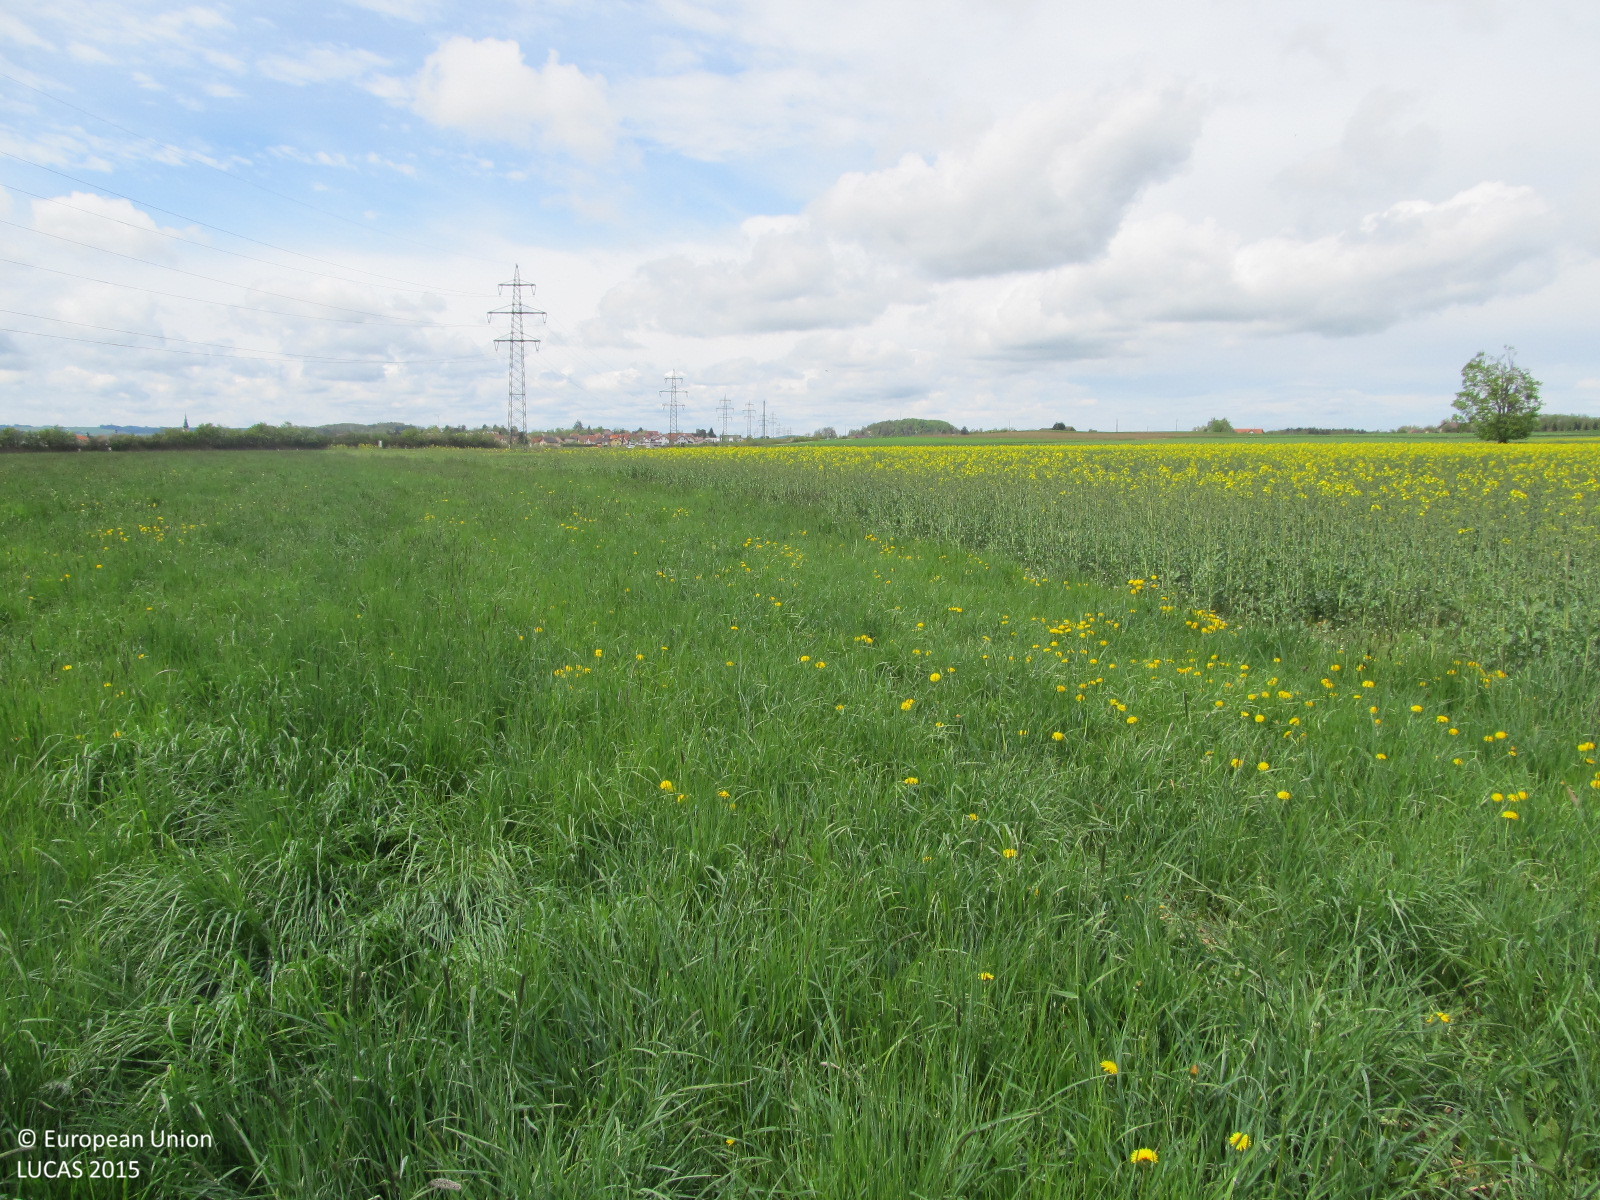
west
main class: Cropland
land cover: Temporary grasslands
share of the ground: > 75 %
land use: Agriculture (excluding fallow land and kitchen gardens)
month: May
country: AT
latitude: 48.5185
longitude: 15.5130
